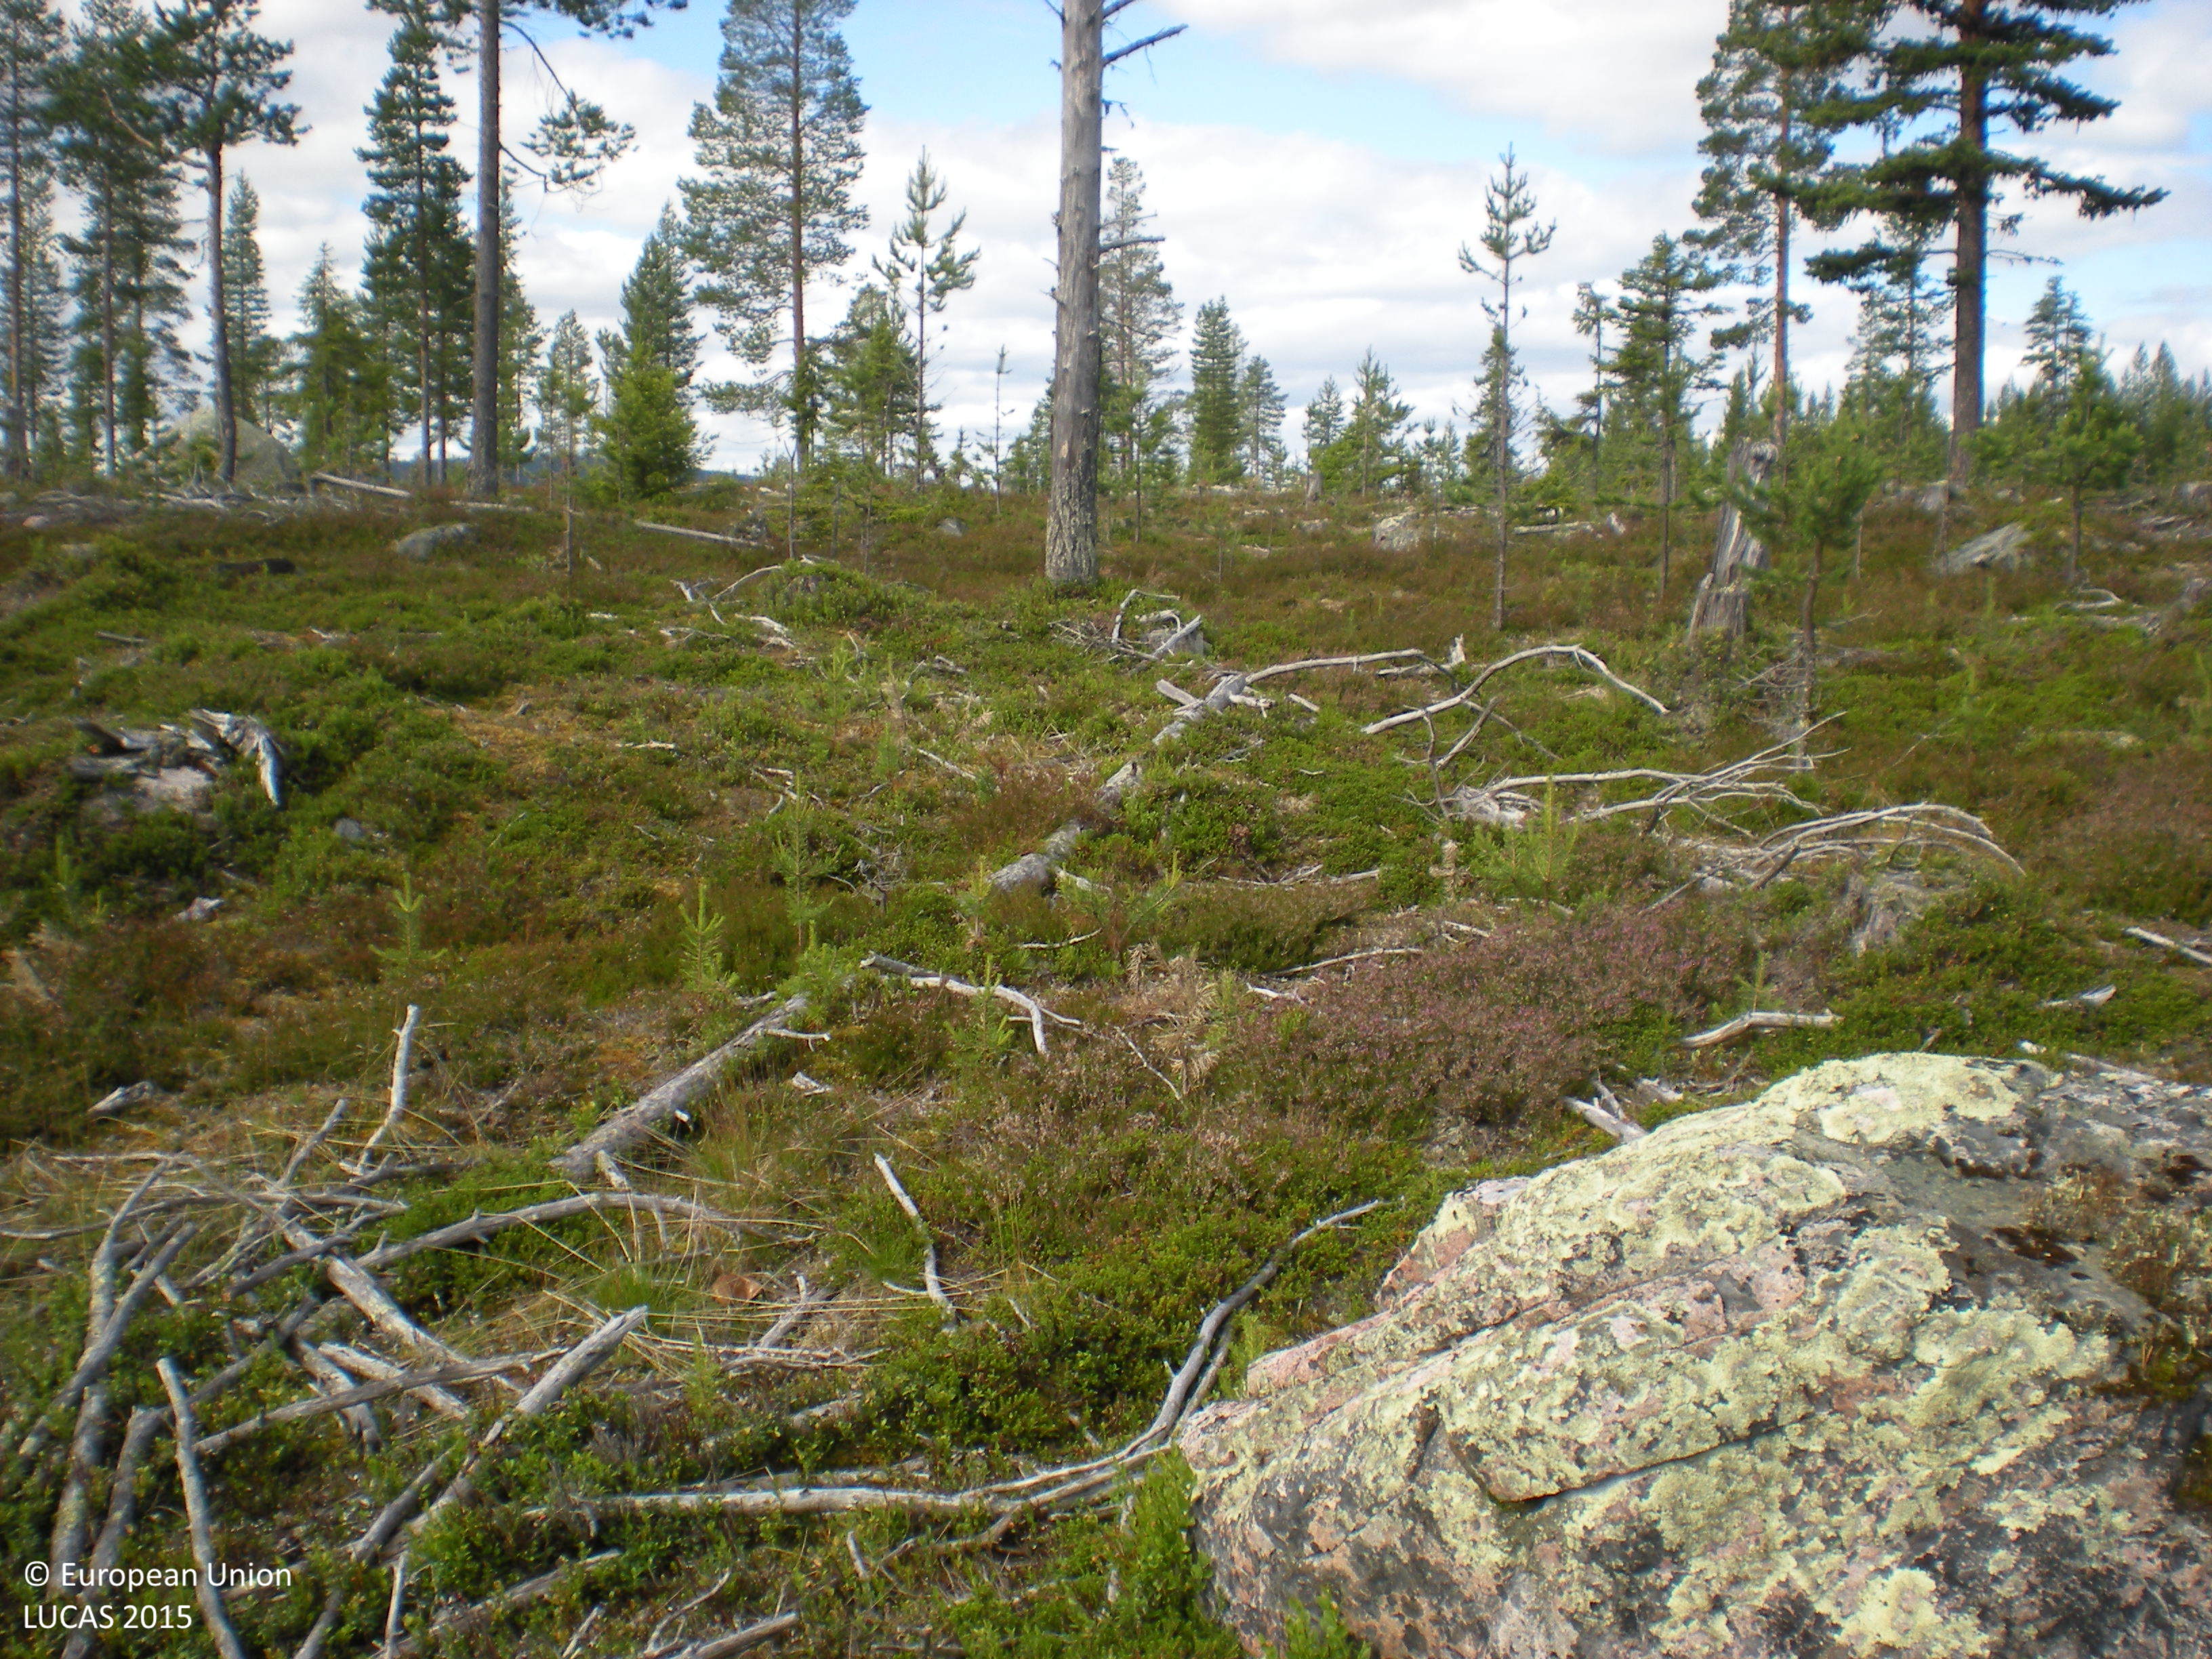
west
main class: Woodland
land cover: Pine dominated coniferous woodland
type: boreal forest
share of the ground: 25 - 50 %
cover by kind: shrubs 50 %, coniferous forest trees 30 %, lichens and mosses 10 %, consolidated bare surface 5 %
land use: Forestry
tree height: < 5 m
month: August
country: SE
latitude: 65.8464
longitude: 18.0824
